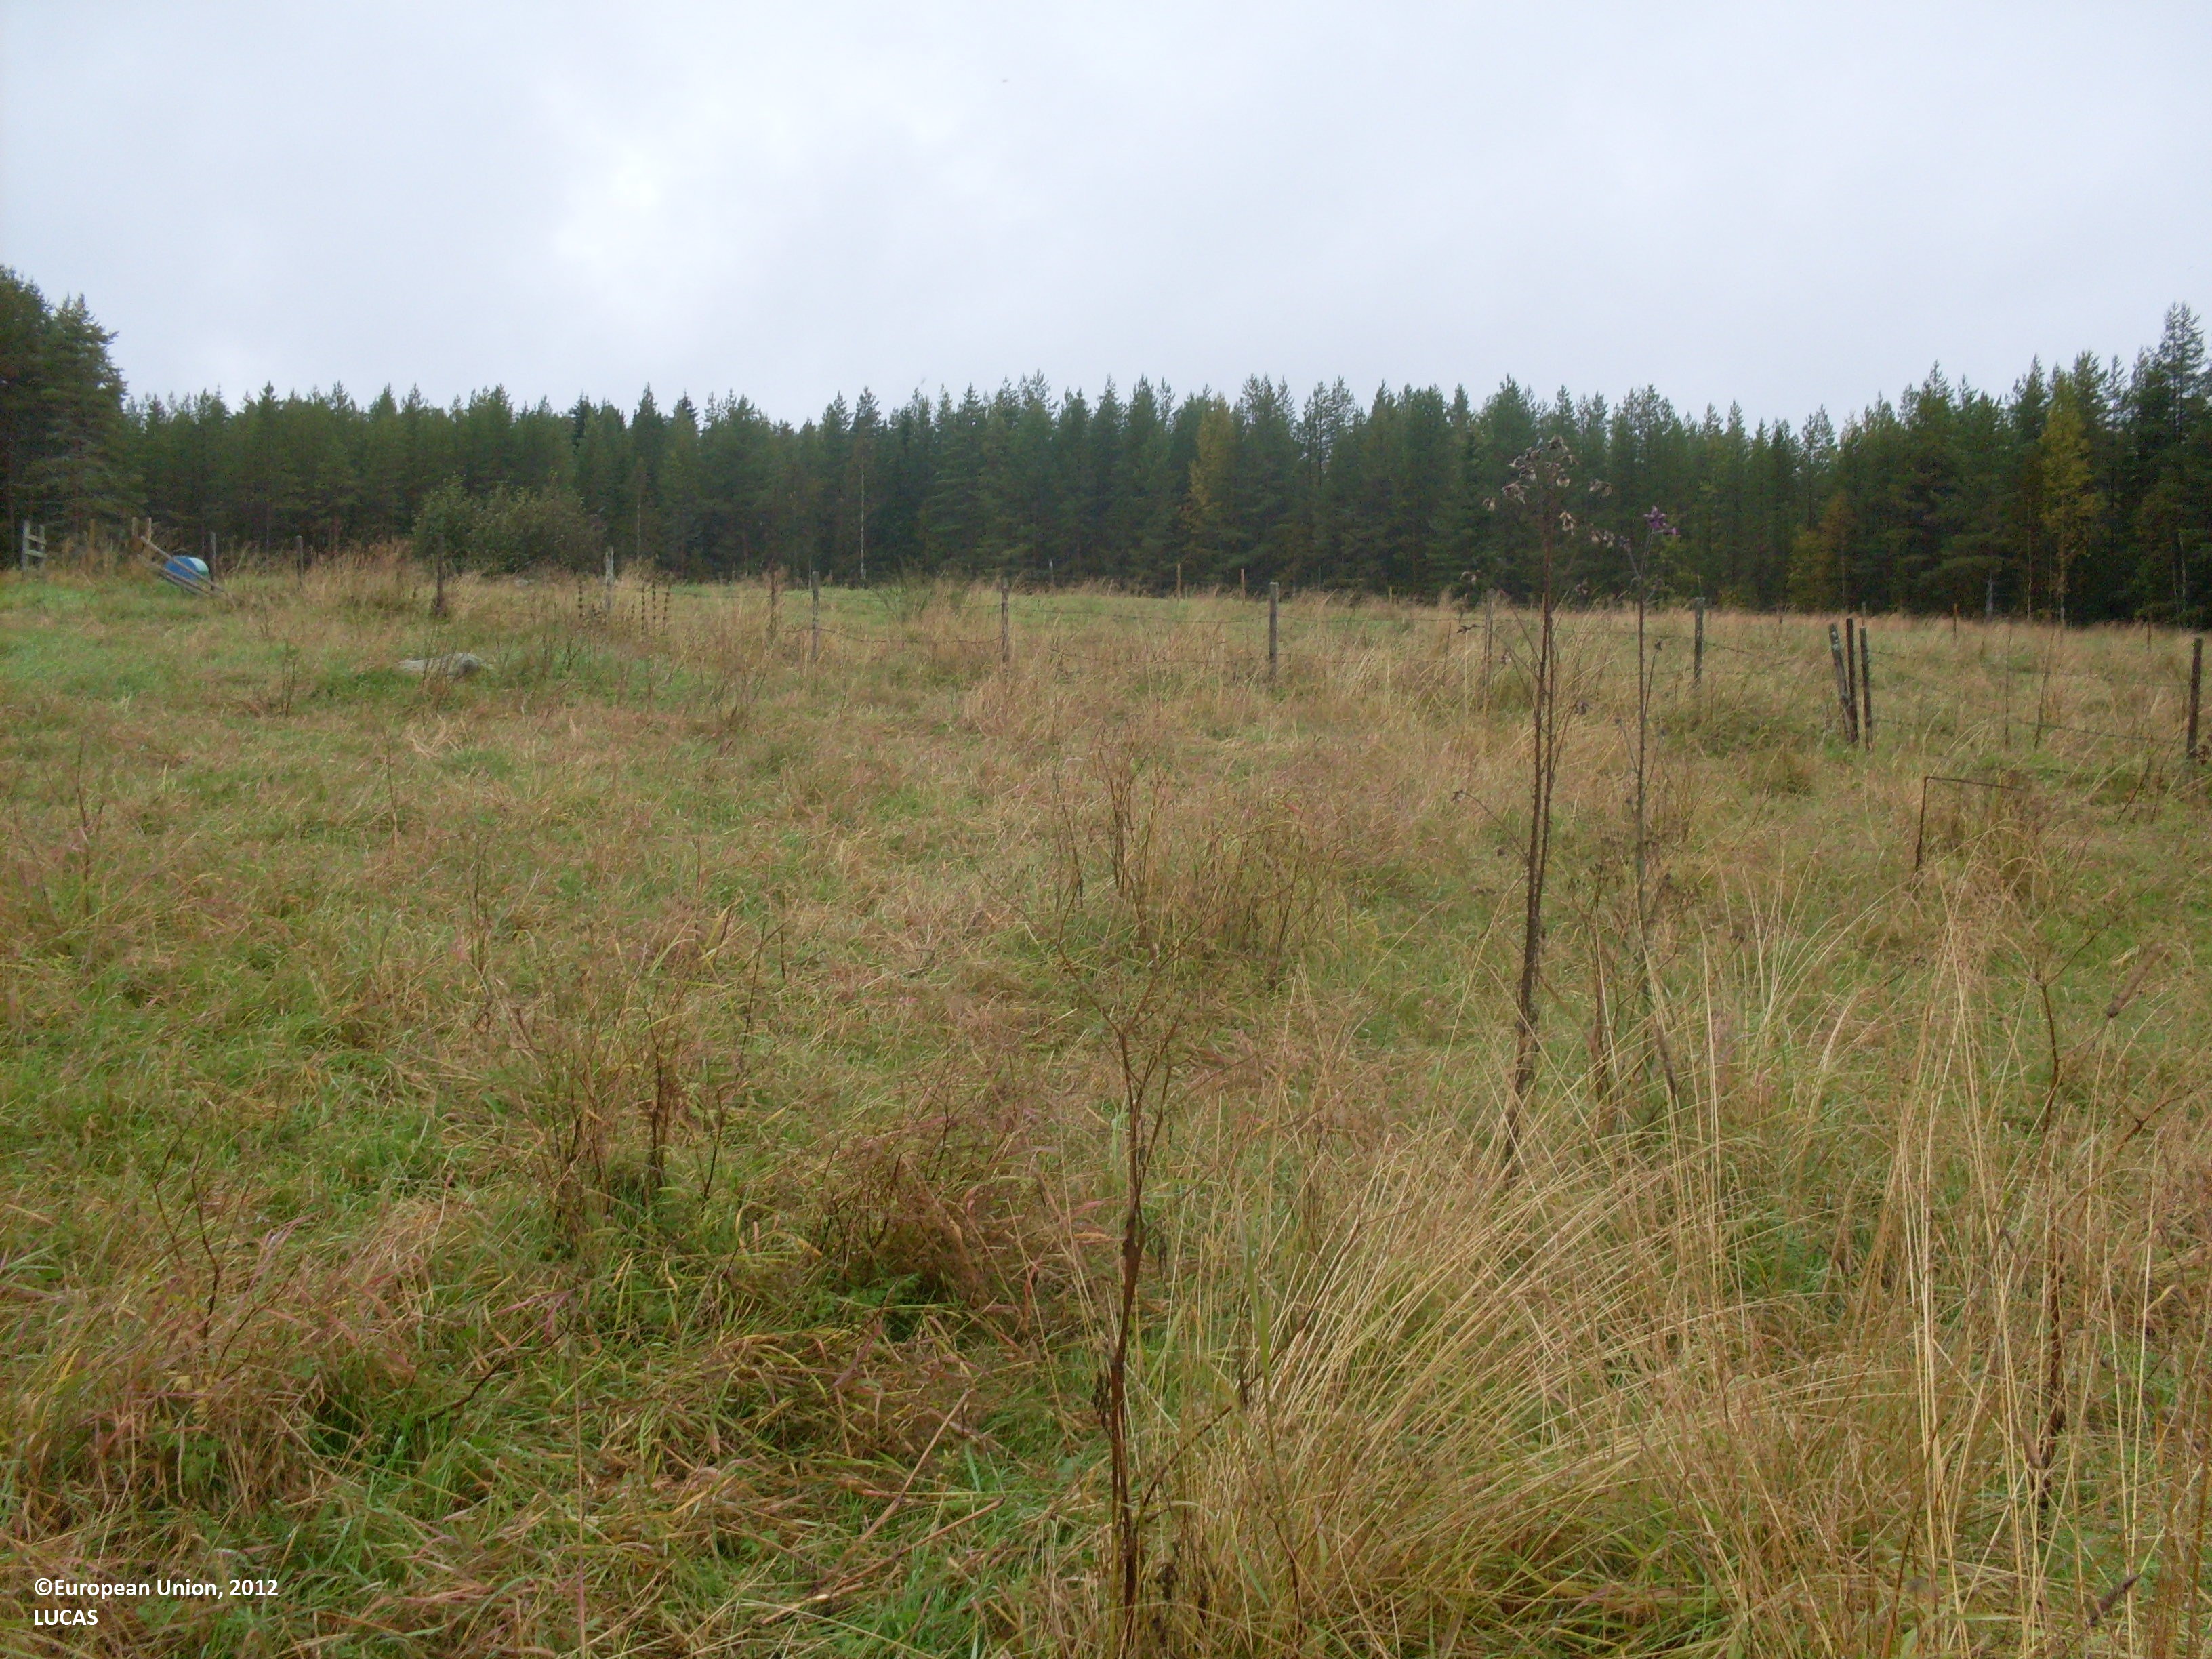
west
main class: Grassland
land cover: Grassland without tree/shrub cover
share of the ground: > 75 %
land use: Agriculture (excluding fallow land and kitchen gardens)
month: September
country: FI
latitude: 64.1477
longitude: 29.6054
